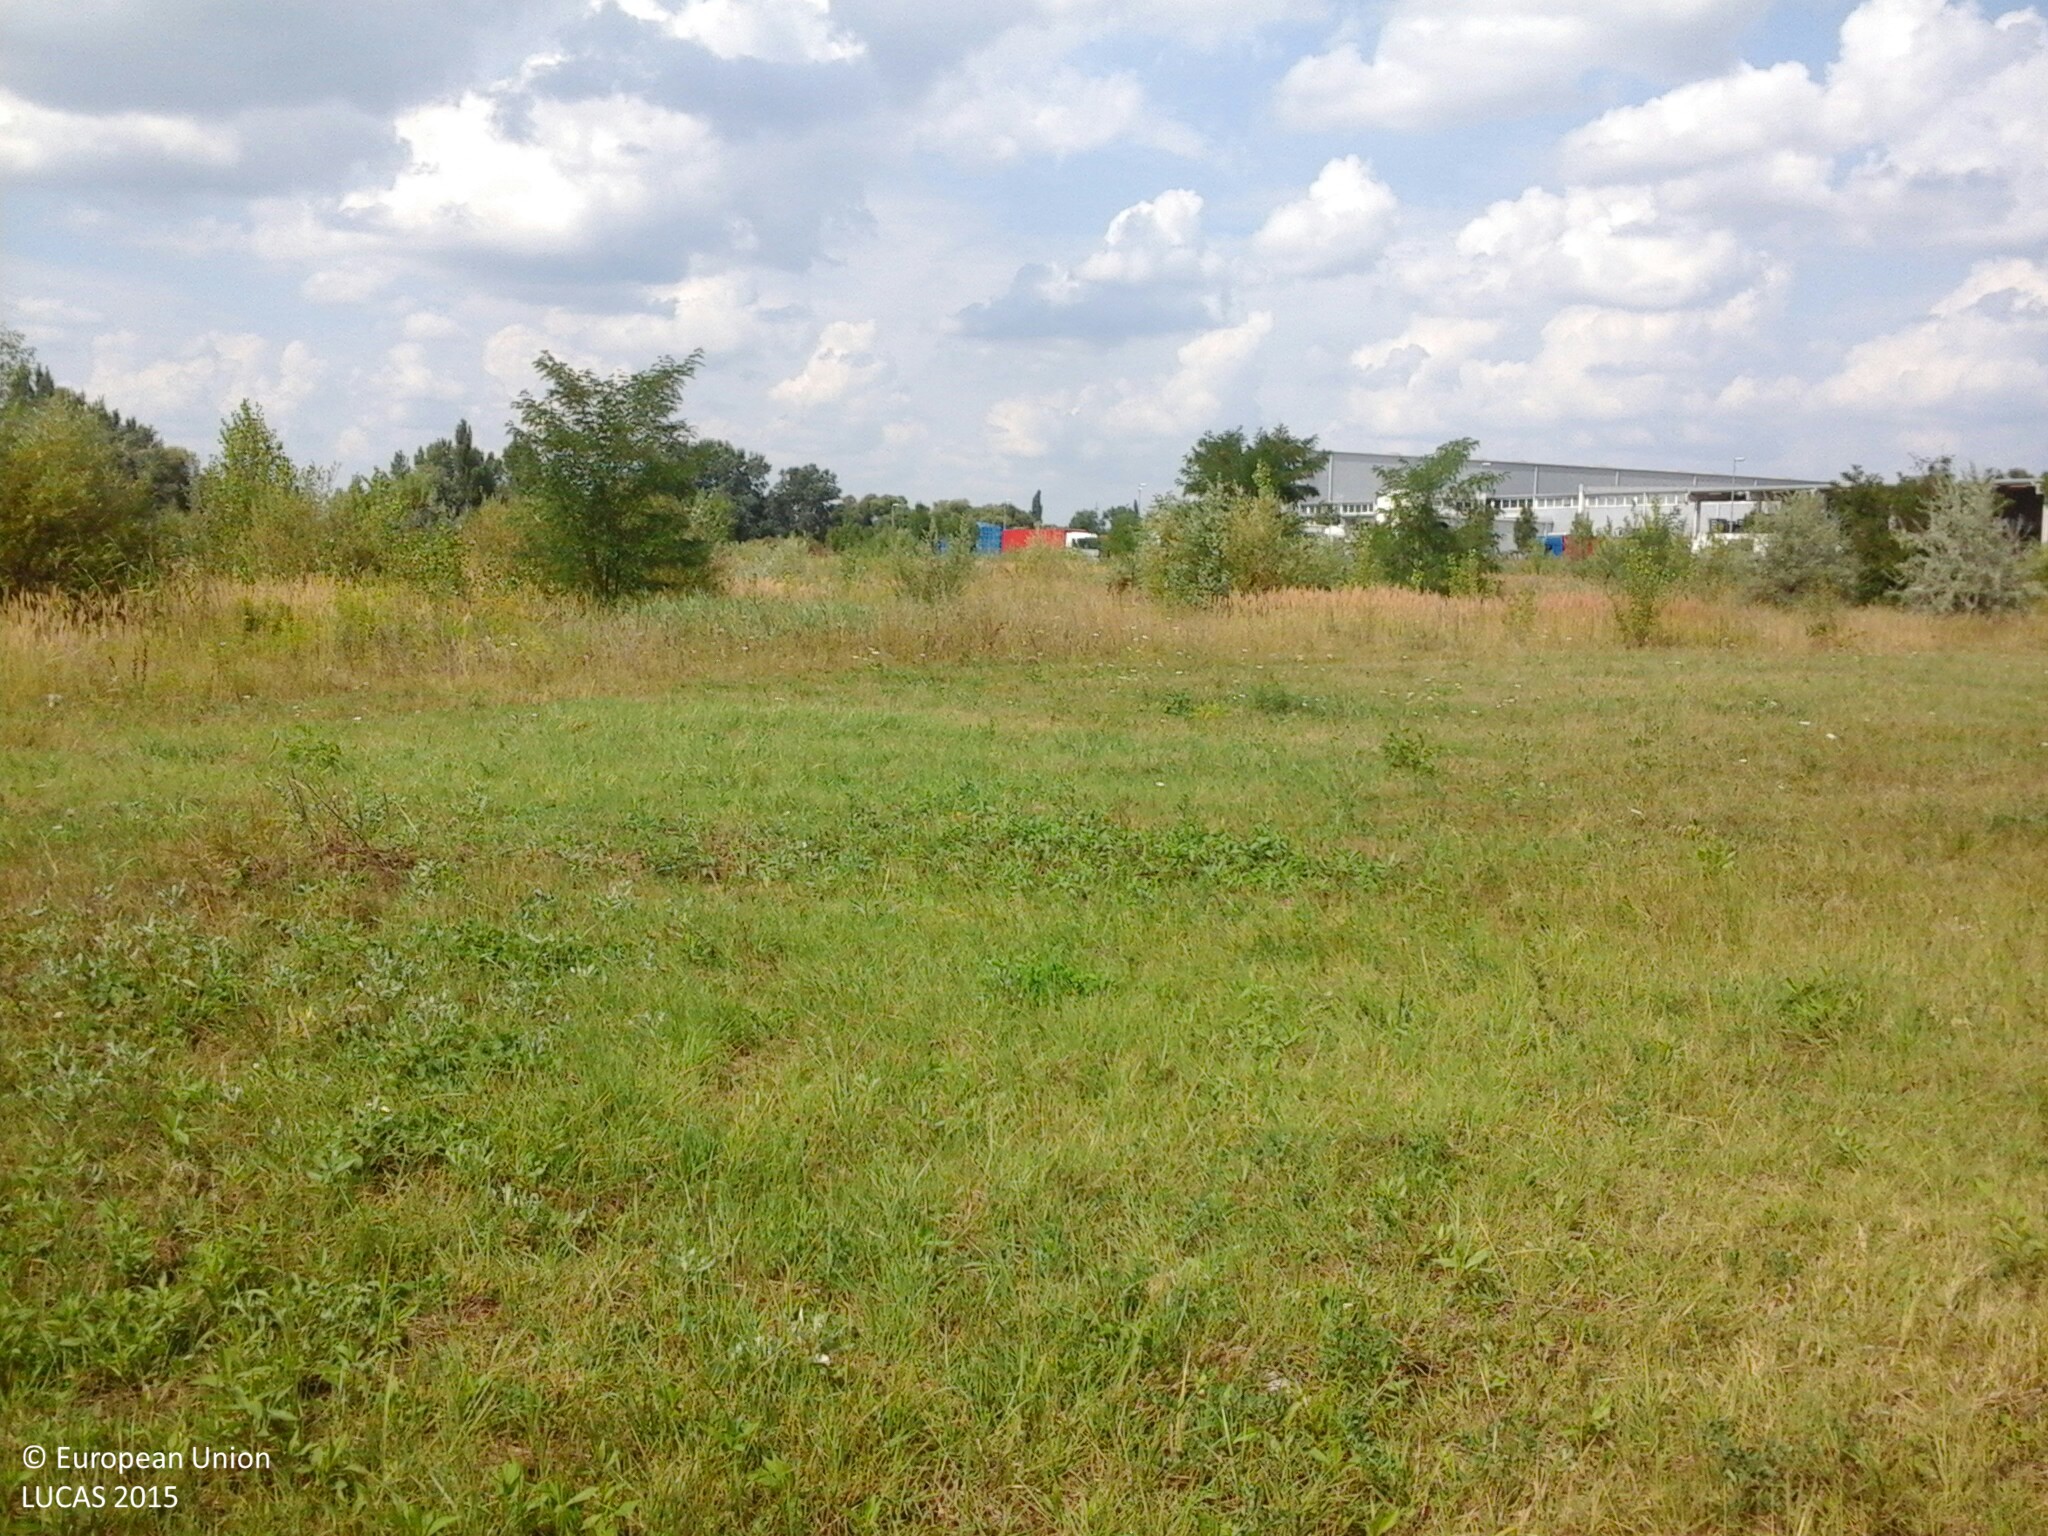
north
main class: Grassland
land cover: Grassland without tree/shrub cover
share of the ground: > 75 %
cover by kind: herbaceous plants 100 %
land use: Semi-natural and natural areas not in use
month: August
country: HU
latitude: 47.3763
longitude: 18.1831
